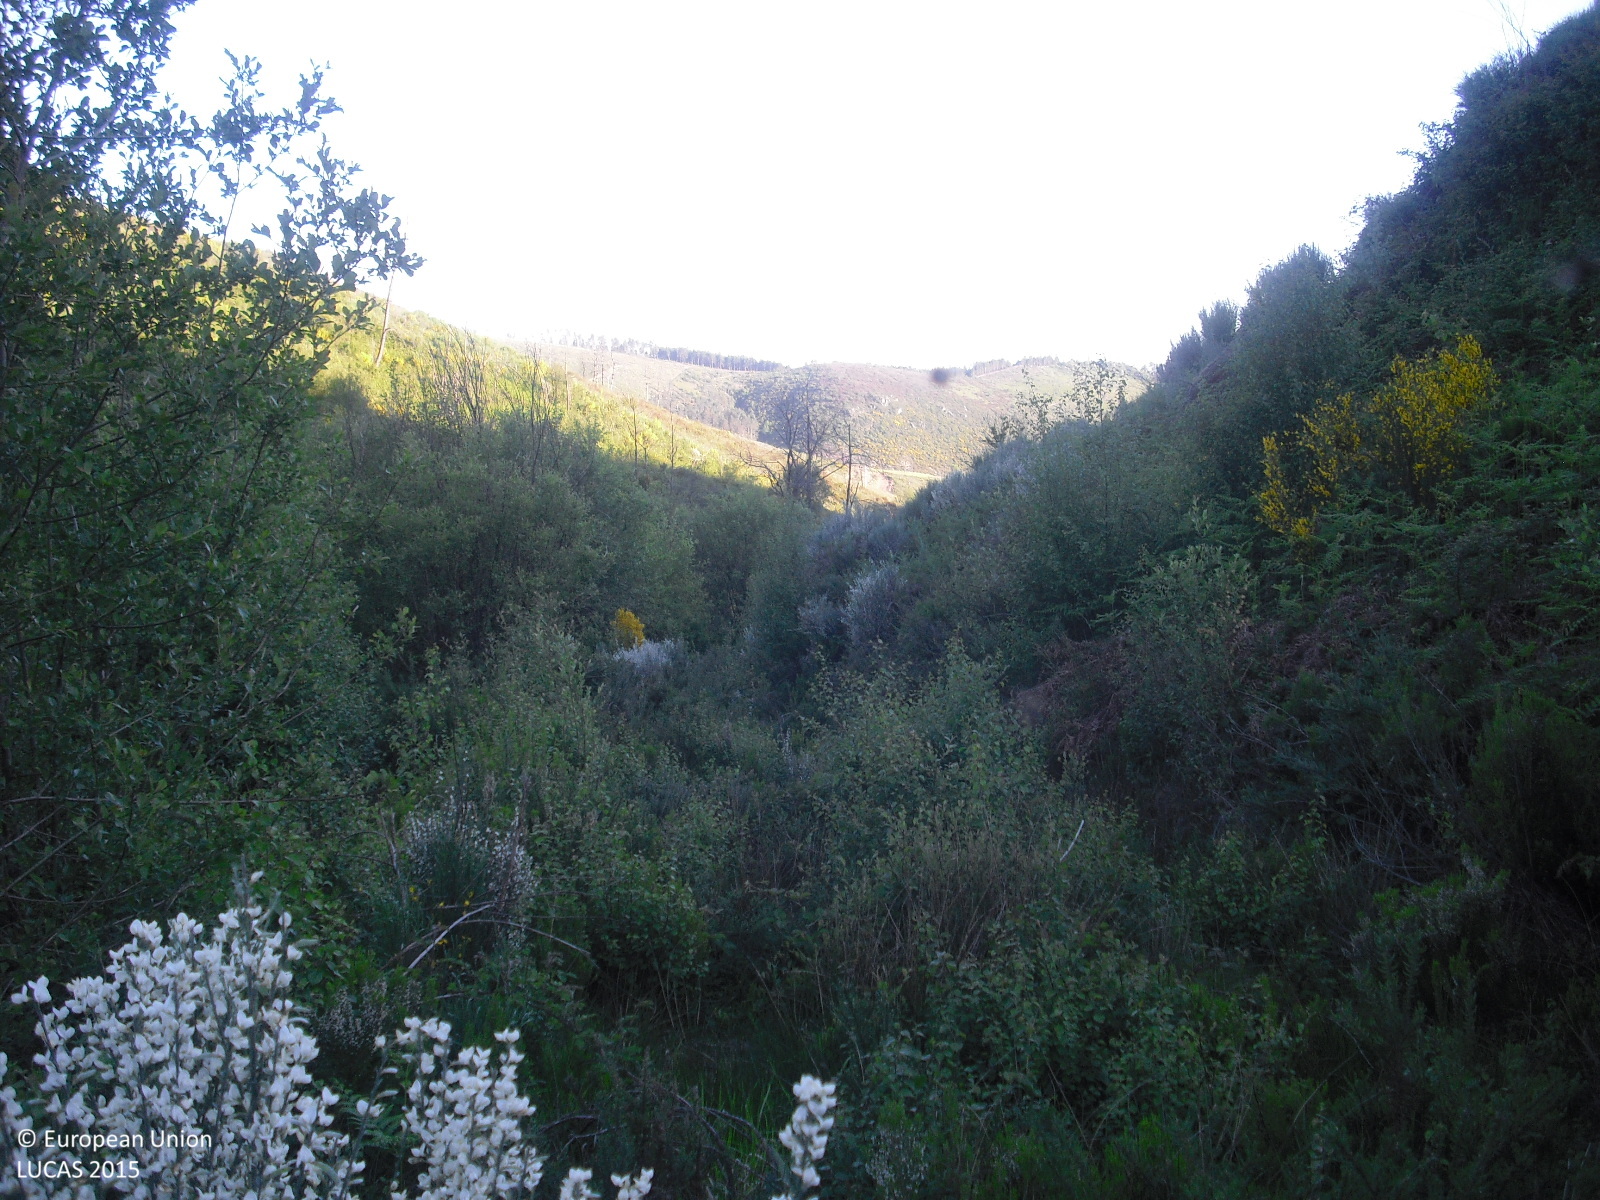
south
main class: Shrubland
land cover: Shrubland with sparse tree cover
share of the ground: > 75 %
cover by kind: shrubs 80 %, herbaceous plants 15 %, broadleaved forest trees 5 %
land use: Forestry
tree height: < 5 m
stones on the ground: 25 - 50 %
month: May
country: ES
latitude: 42.0249
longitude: -7.3663
